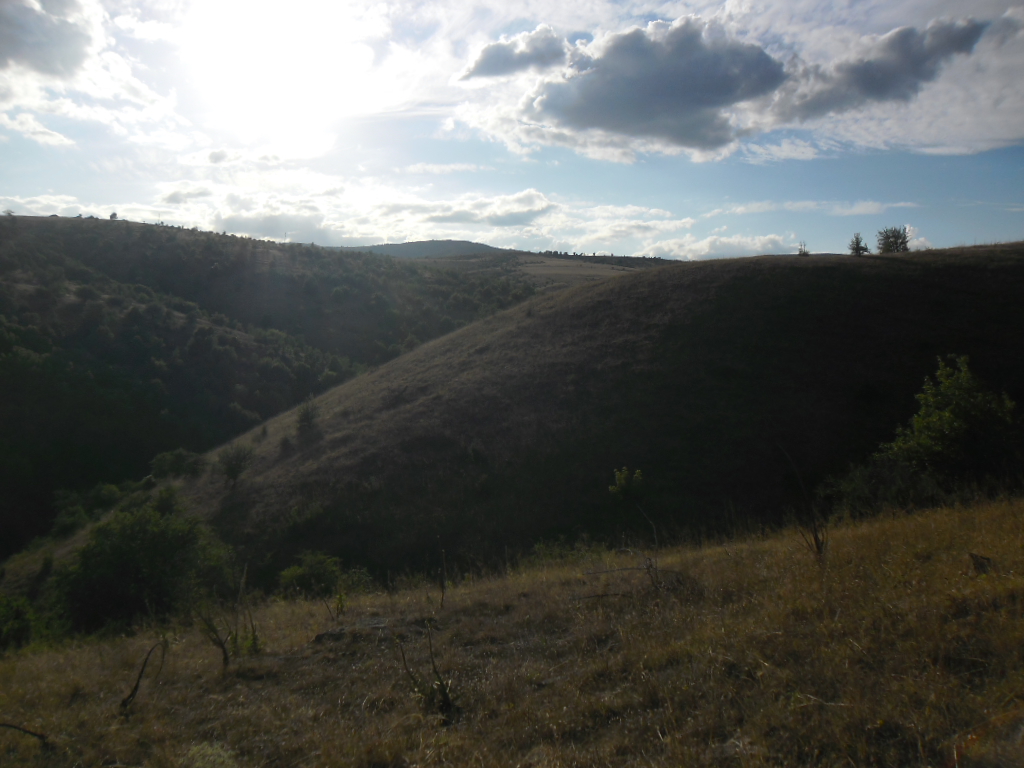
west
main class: Grassland
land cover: Grassland with sparse tree/shrub cover
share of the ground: > 75 %
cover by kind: herbaceous plants 90 %, broadleaved forest trees 5 %, shrubs 5 %
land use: Agriculture (excluding fallow land and kitchen gardens)
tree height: < 5 m
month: August
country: BG
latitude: 42.0336
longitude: 22.9839
